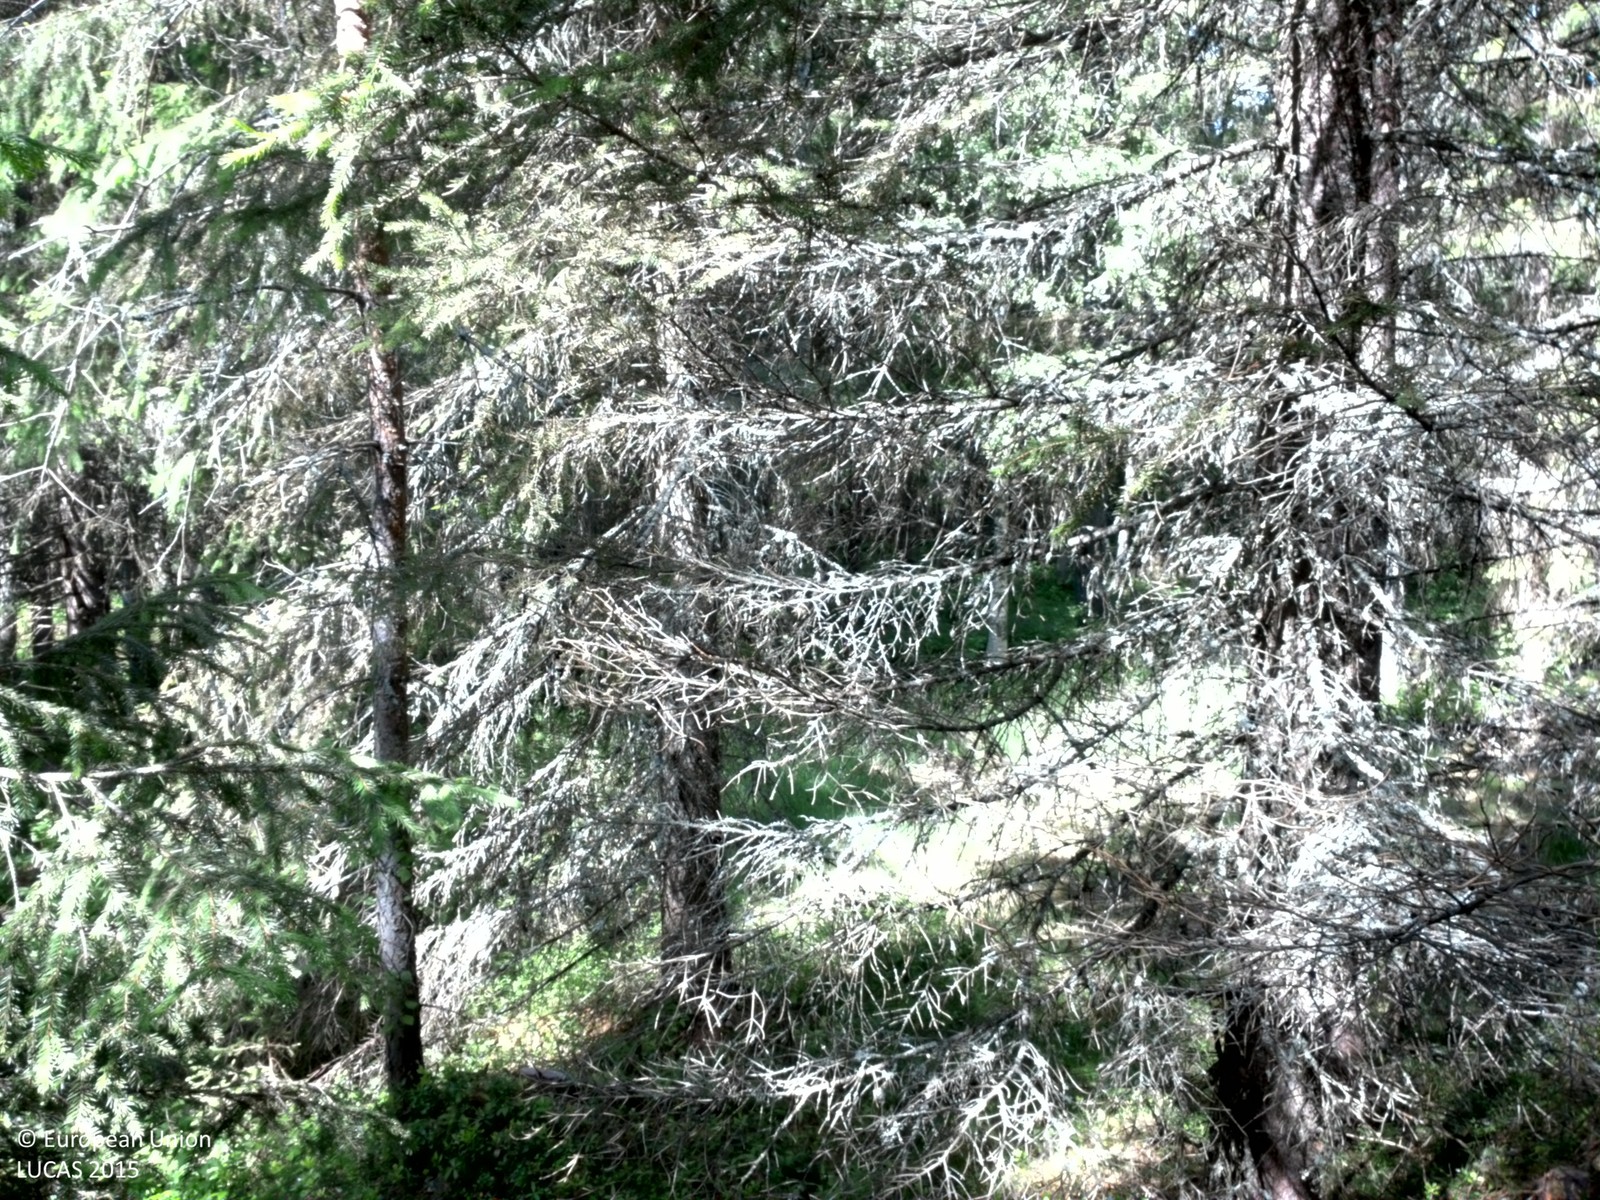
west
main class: Woodland
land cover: Spruce dominated coniferous woodland
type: boreal forest
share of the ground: 50 - 75 %
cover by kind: coniferous forest trees 75 %, shrubs 20 %, herbaceous plants 5 %
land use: Forestry
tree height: > 5 m
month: July
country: SE
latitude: 64.3005
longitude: 20.8322
